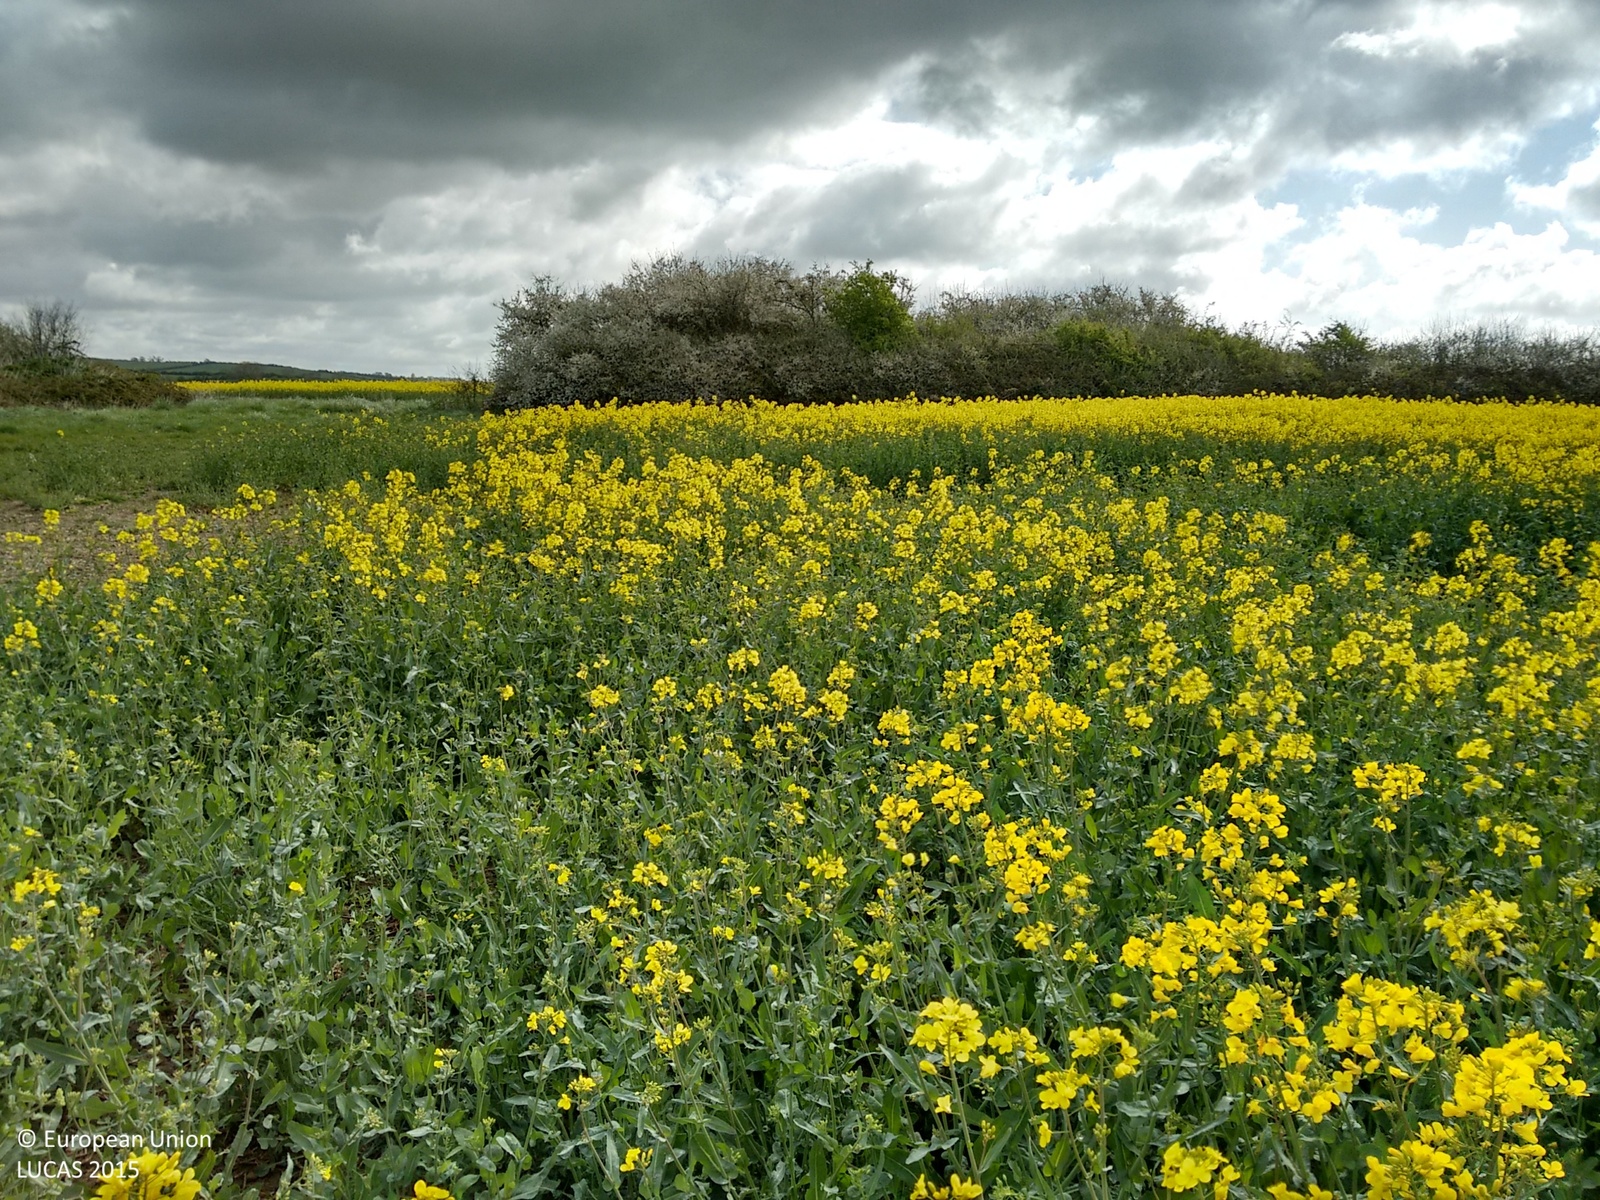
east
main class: Cropland
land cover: Rape and turnip rape
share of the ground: > 75 %
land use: Agriculture (excluding fallow land and kitchen gardens)
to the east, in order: Rape and turnip rape; Broadleaved woodland; Grassland without tree/shrub cover; Rape and turnip rape
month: April
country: GB
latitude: 51.8470
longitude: -0.7985
